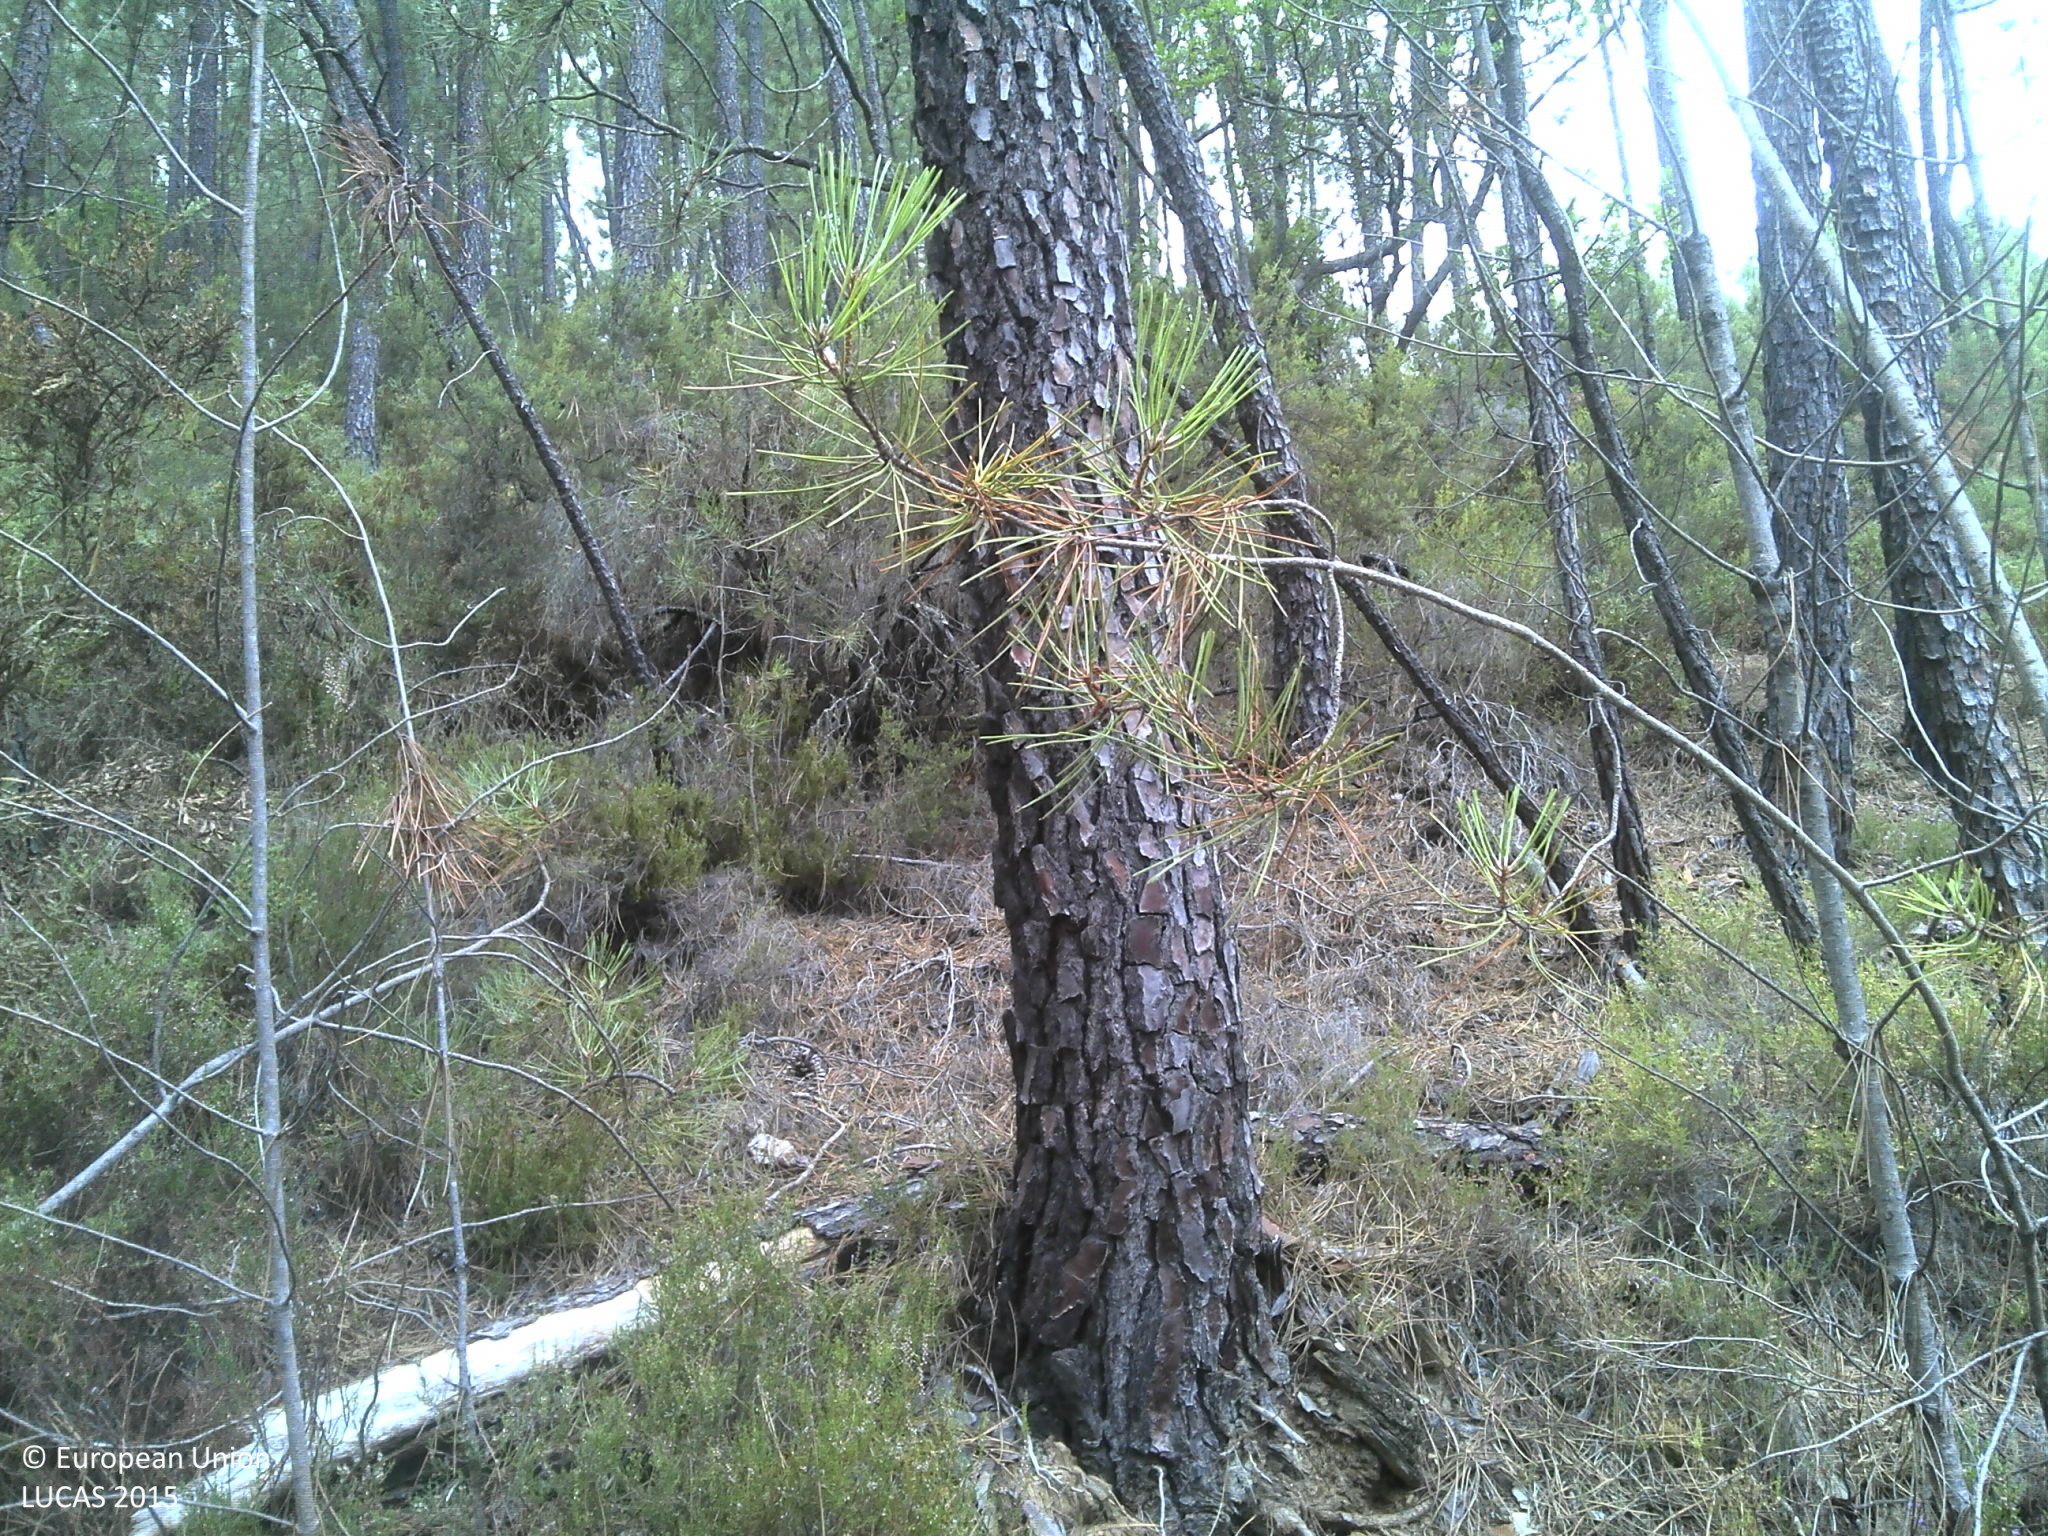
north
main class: Woodland
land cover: Pine dominated coniferous woodland
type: coniferous forest of the mediterranean region
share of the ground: 50 - 75 %
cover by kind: coniferous forest trees 60 %, shrubs 30 %, unconsolidated bare surface 10 %
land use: Forestry
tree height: > 5 m
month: July
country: PT
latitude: 40.3098
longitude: -7.7764
